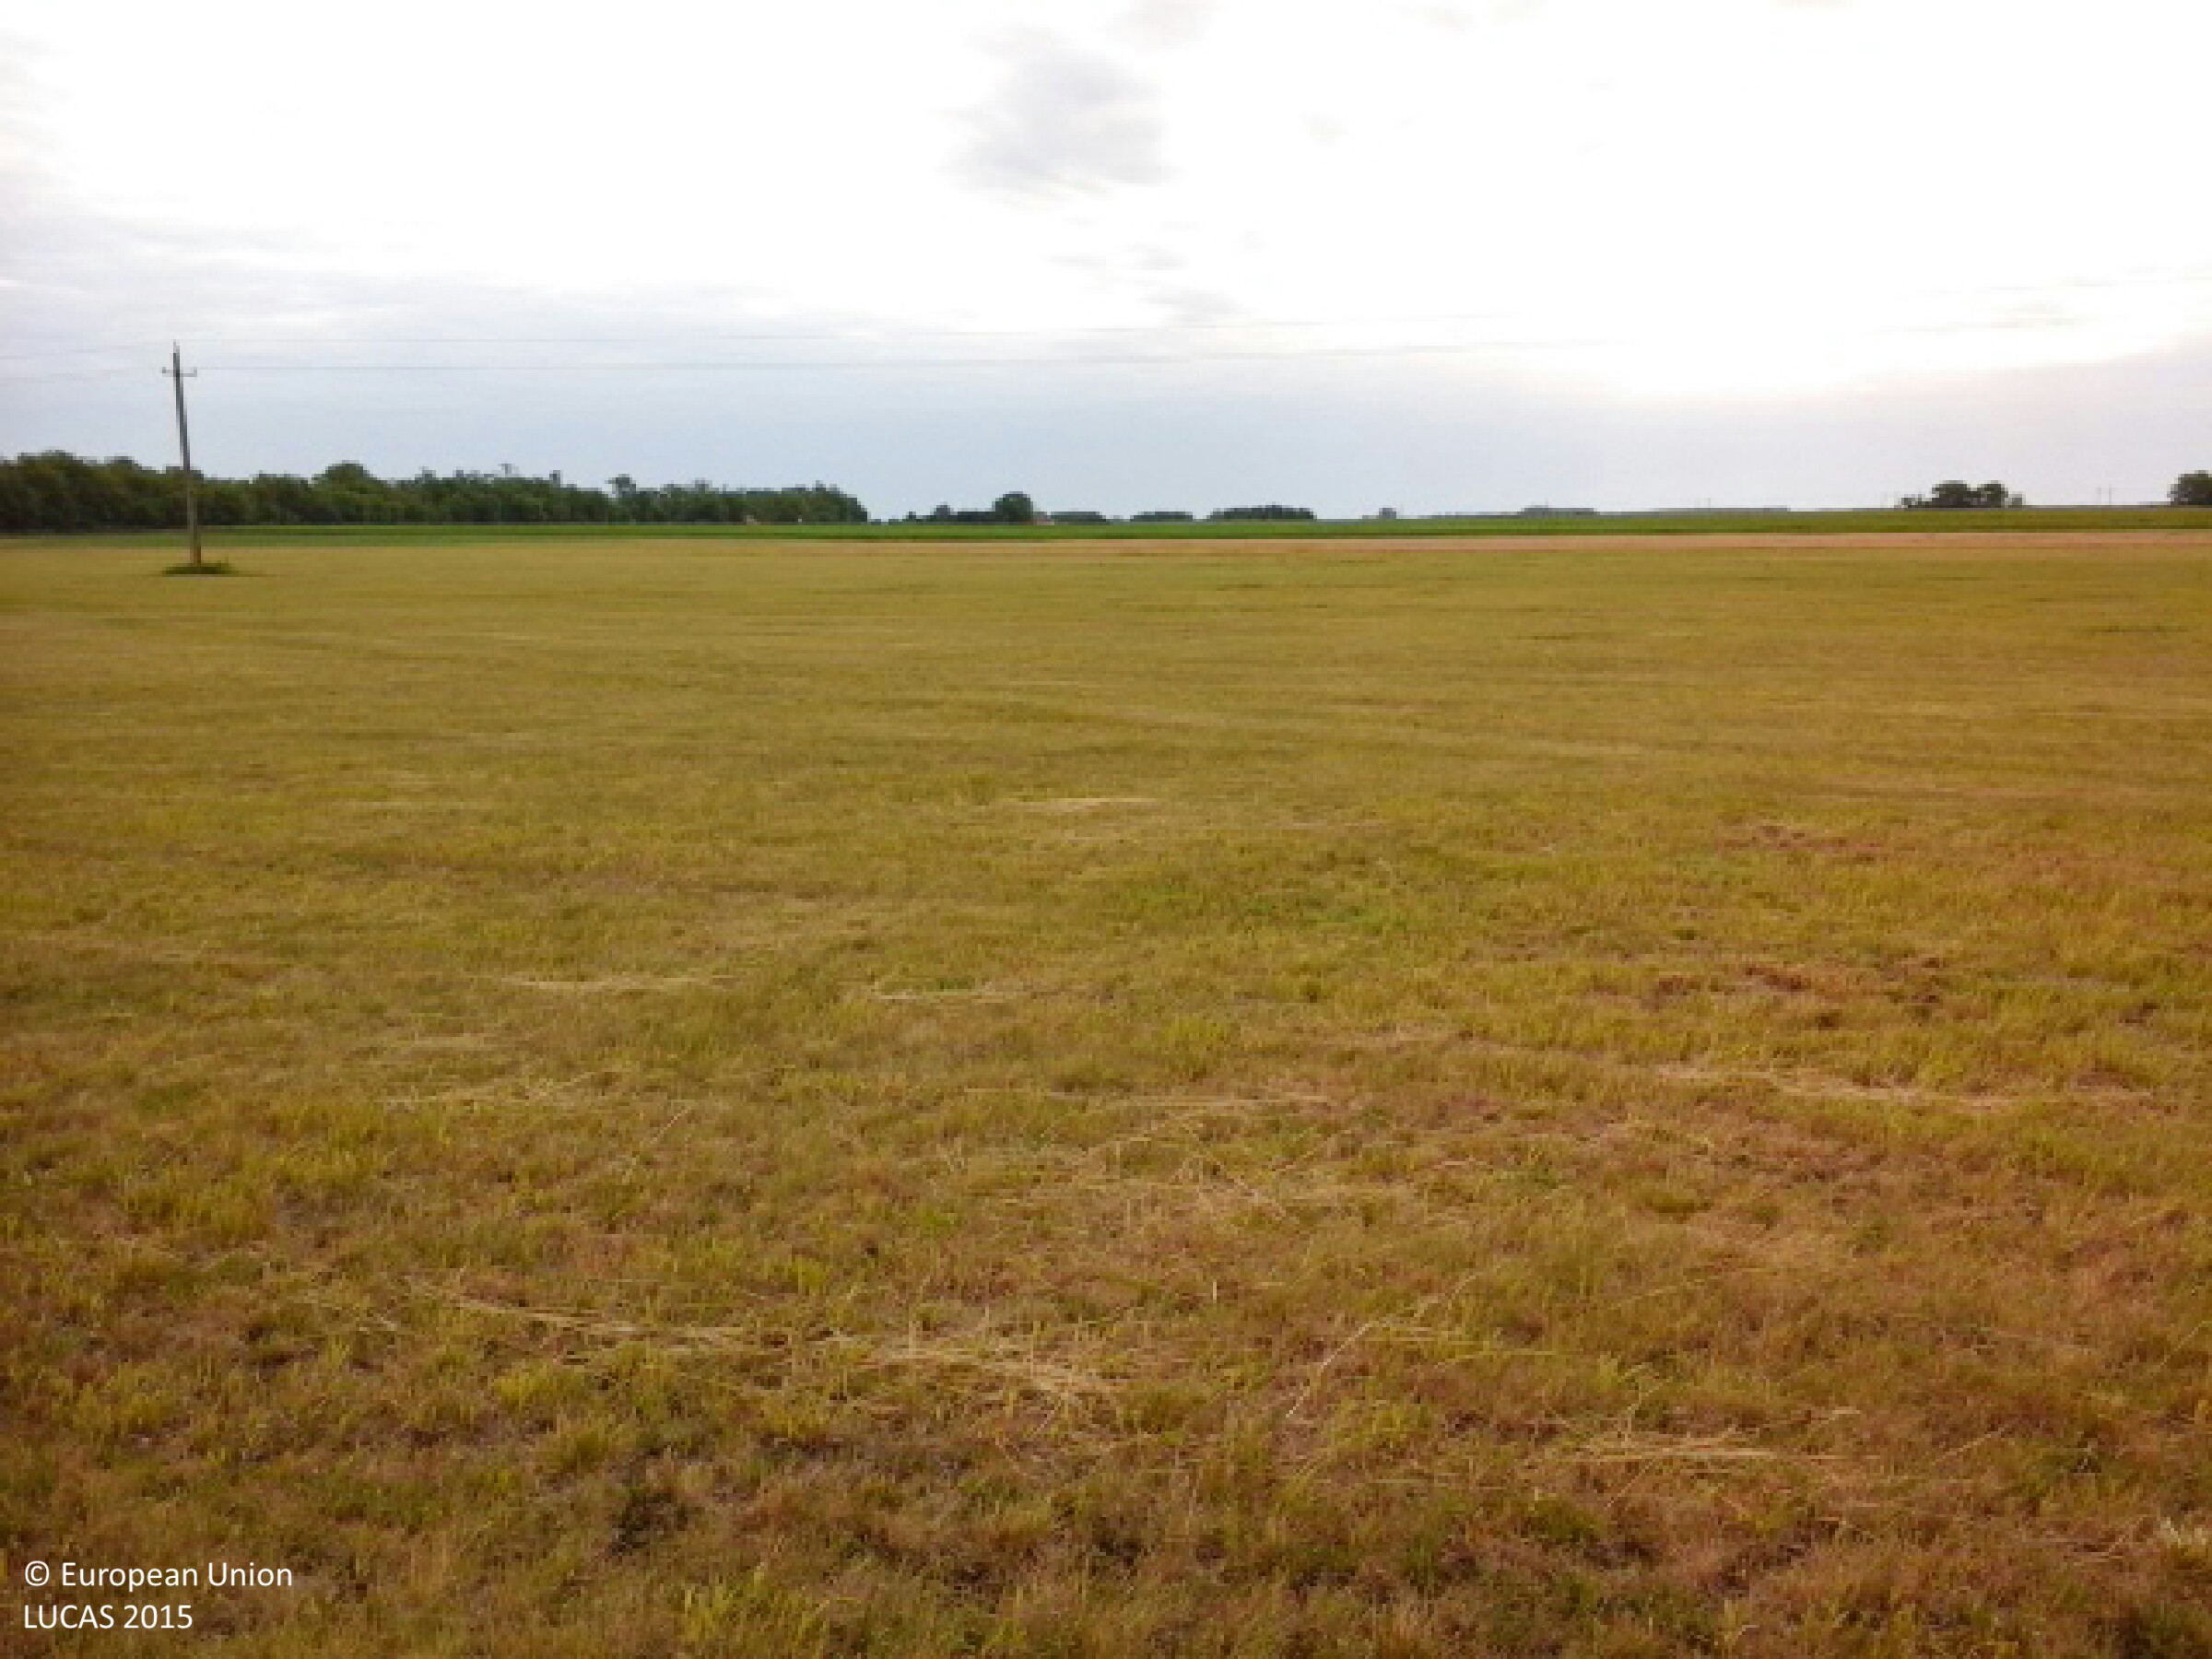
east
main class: Grassland
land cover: Grassland without tree/shrub cover
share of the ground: > 75 %
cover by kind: herbaceous plants 95 %, unconsolidated bare surface 5 %
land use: Agriculture (excluding fallow land and kitchen gardens)
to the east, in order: Grassland without tree/shrub cover; Electric lines; Grassland without tree/shrub cover; Tracks; Grassland without tree/shrub cover
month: June
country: HU
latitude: 48.0462
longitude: 21.7597
